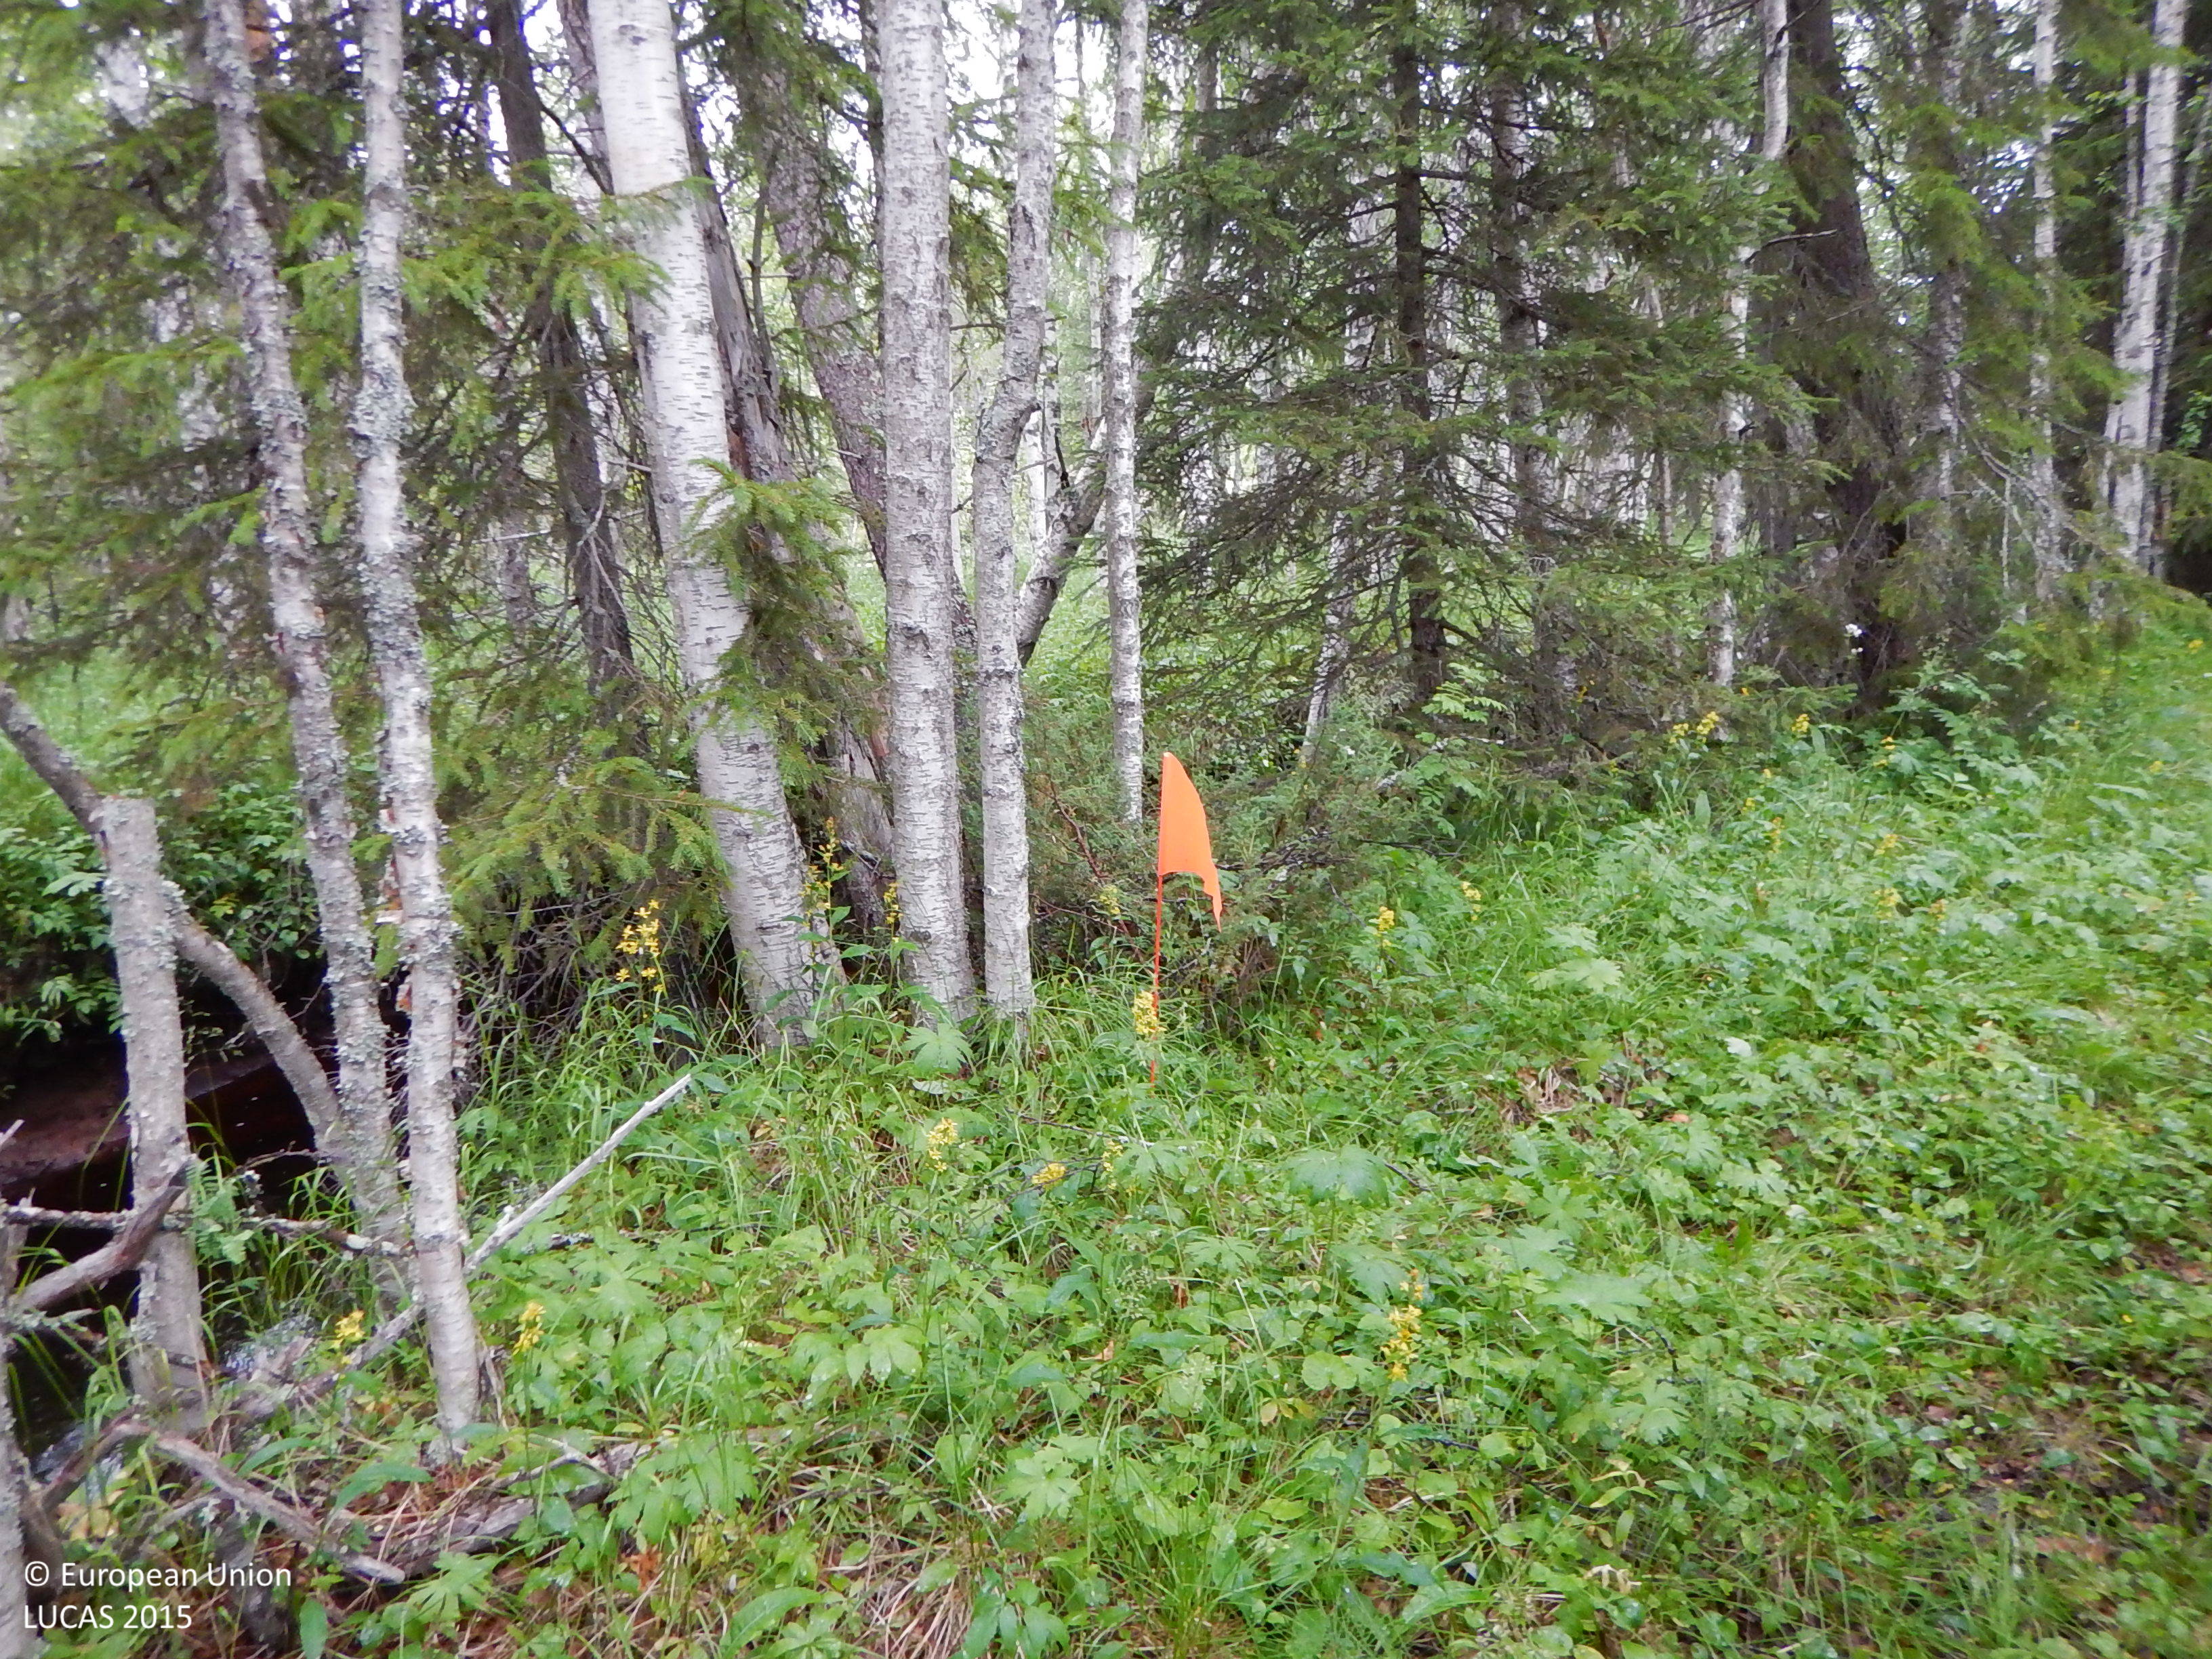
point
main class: Woodland
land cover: Other mixed woodland
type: boreal forest
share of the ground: 50 - 75 %
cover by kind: broadleaved forest trees 40 %, herbaceous plants 20 %, coniferous forest trees 15 %, lichens and mosses 15 %, shrubs 10 %
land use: Forestry
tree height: > 5 m
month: July
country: SE
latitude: 64.9853
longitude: 20.4210
